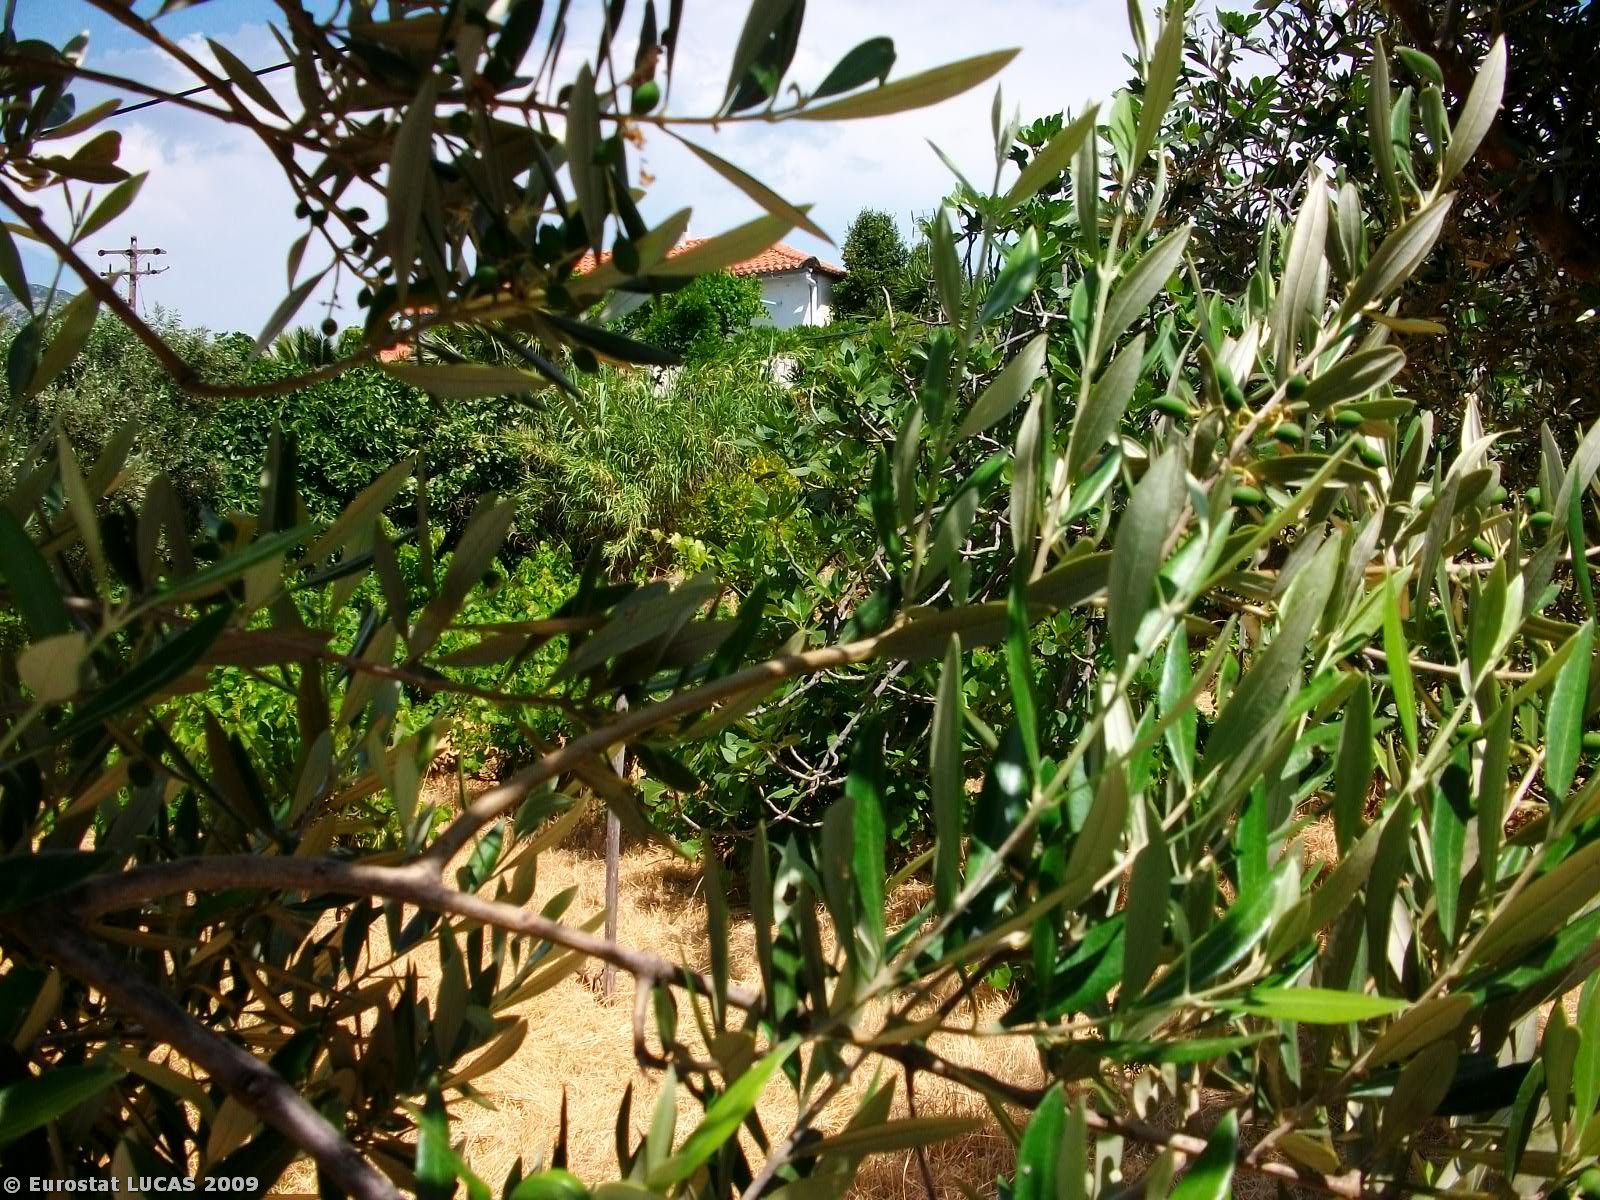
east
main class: Cropland
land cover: Olive groves
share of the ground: 25 - 50 %
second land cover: Vineyards
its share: < 10 %
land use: Agriculture (excluding fallow land and kitchen gardens)
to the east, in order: Olive groves; Vineyards; Grassland with sparse tree/shrub cover; Fences; Artificial constructions in urban areas; Paved roads, cycling and walking lanes; Olive groves; Dry stone walls; Shrubland with sparse tree cover
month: June
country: GR
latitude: 36.8332
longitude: 22.3193
